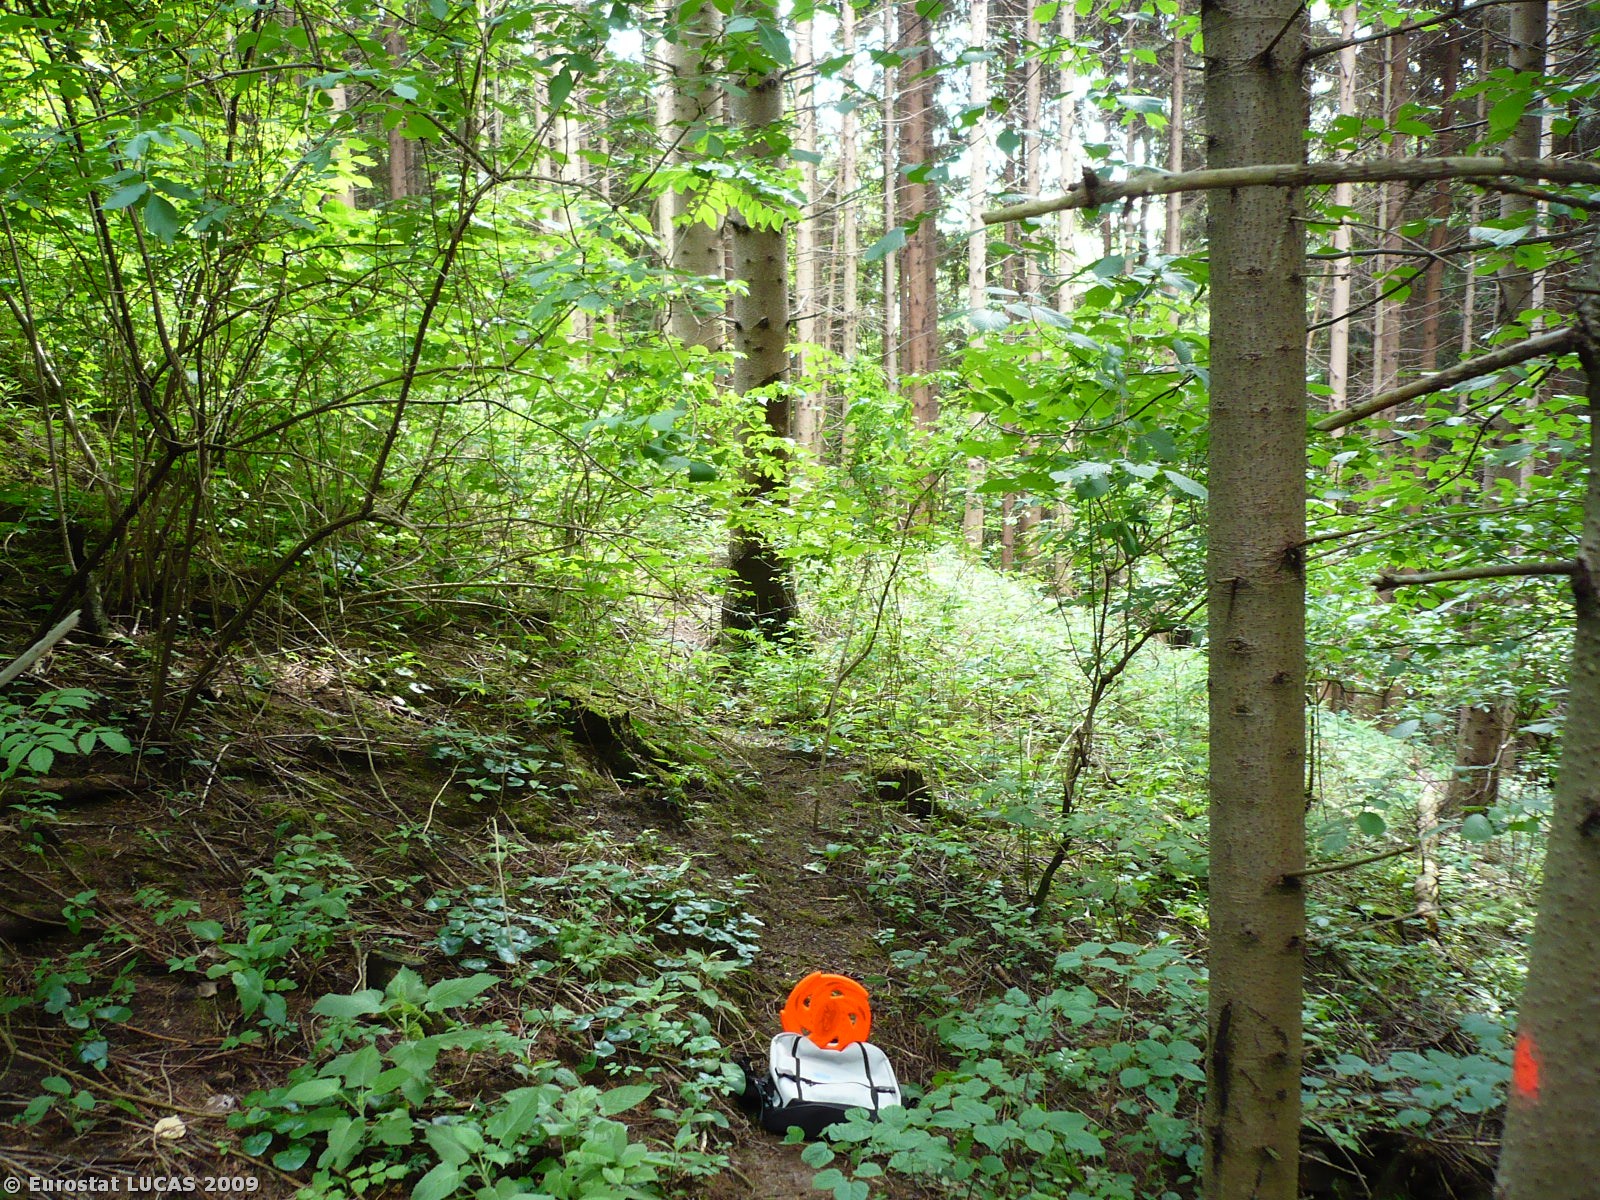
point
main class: Woodland
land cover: Mixed woodland
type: beech forest
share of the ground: > 75 %
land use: Forestry
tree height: > 5 m
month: June
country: SI
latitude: 46.0724
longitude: 13.6553
